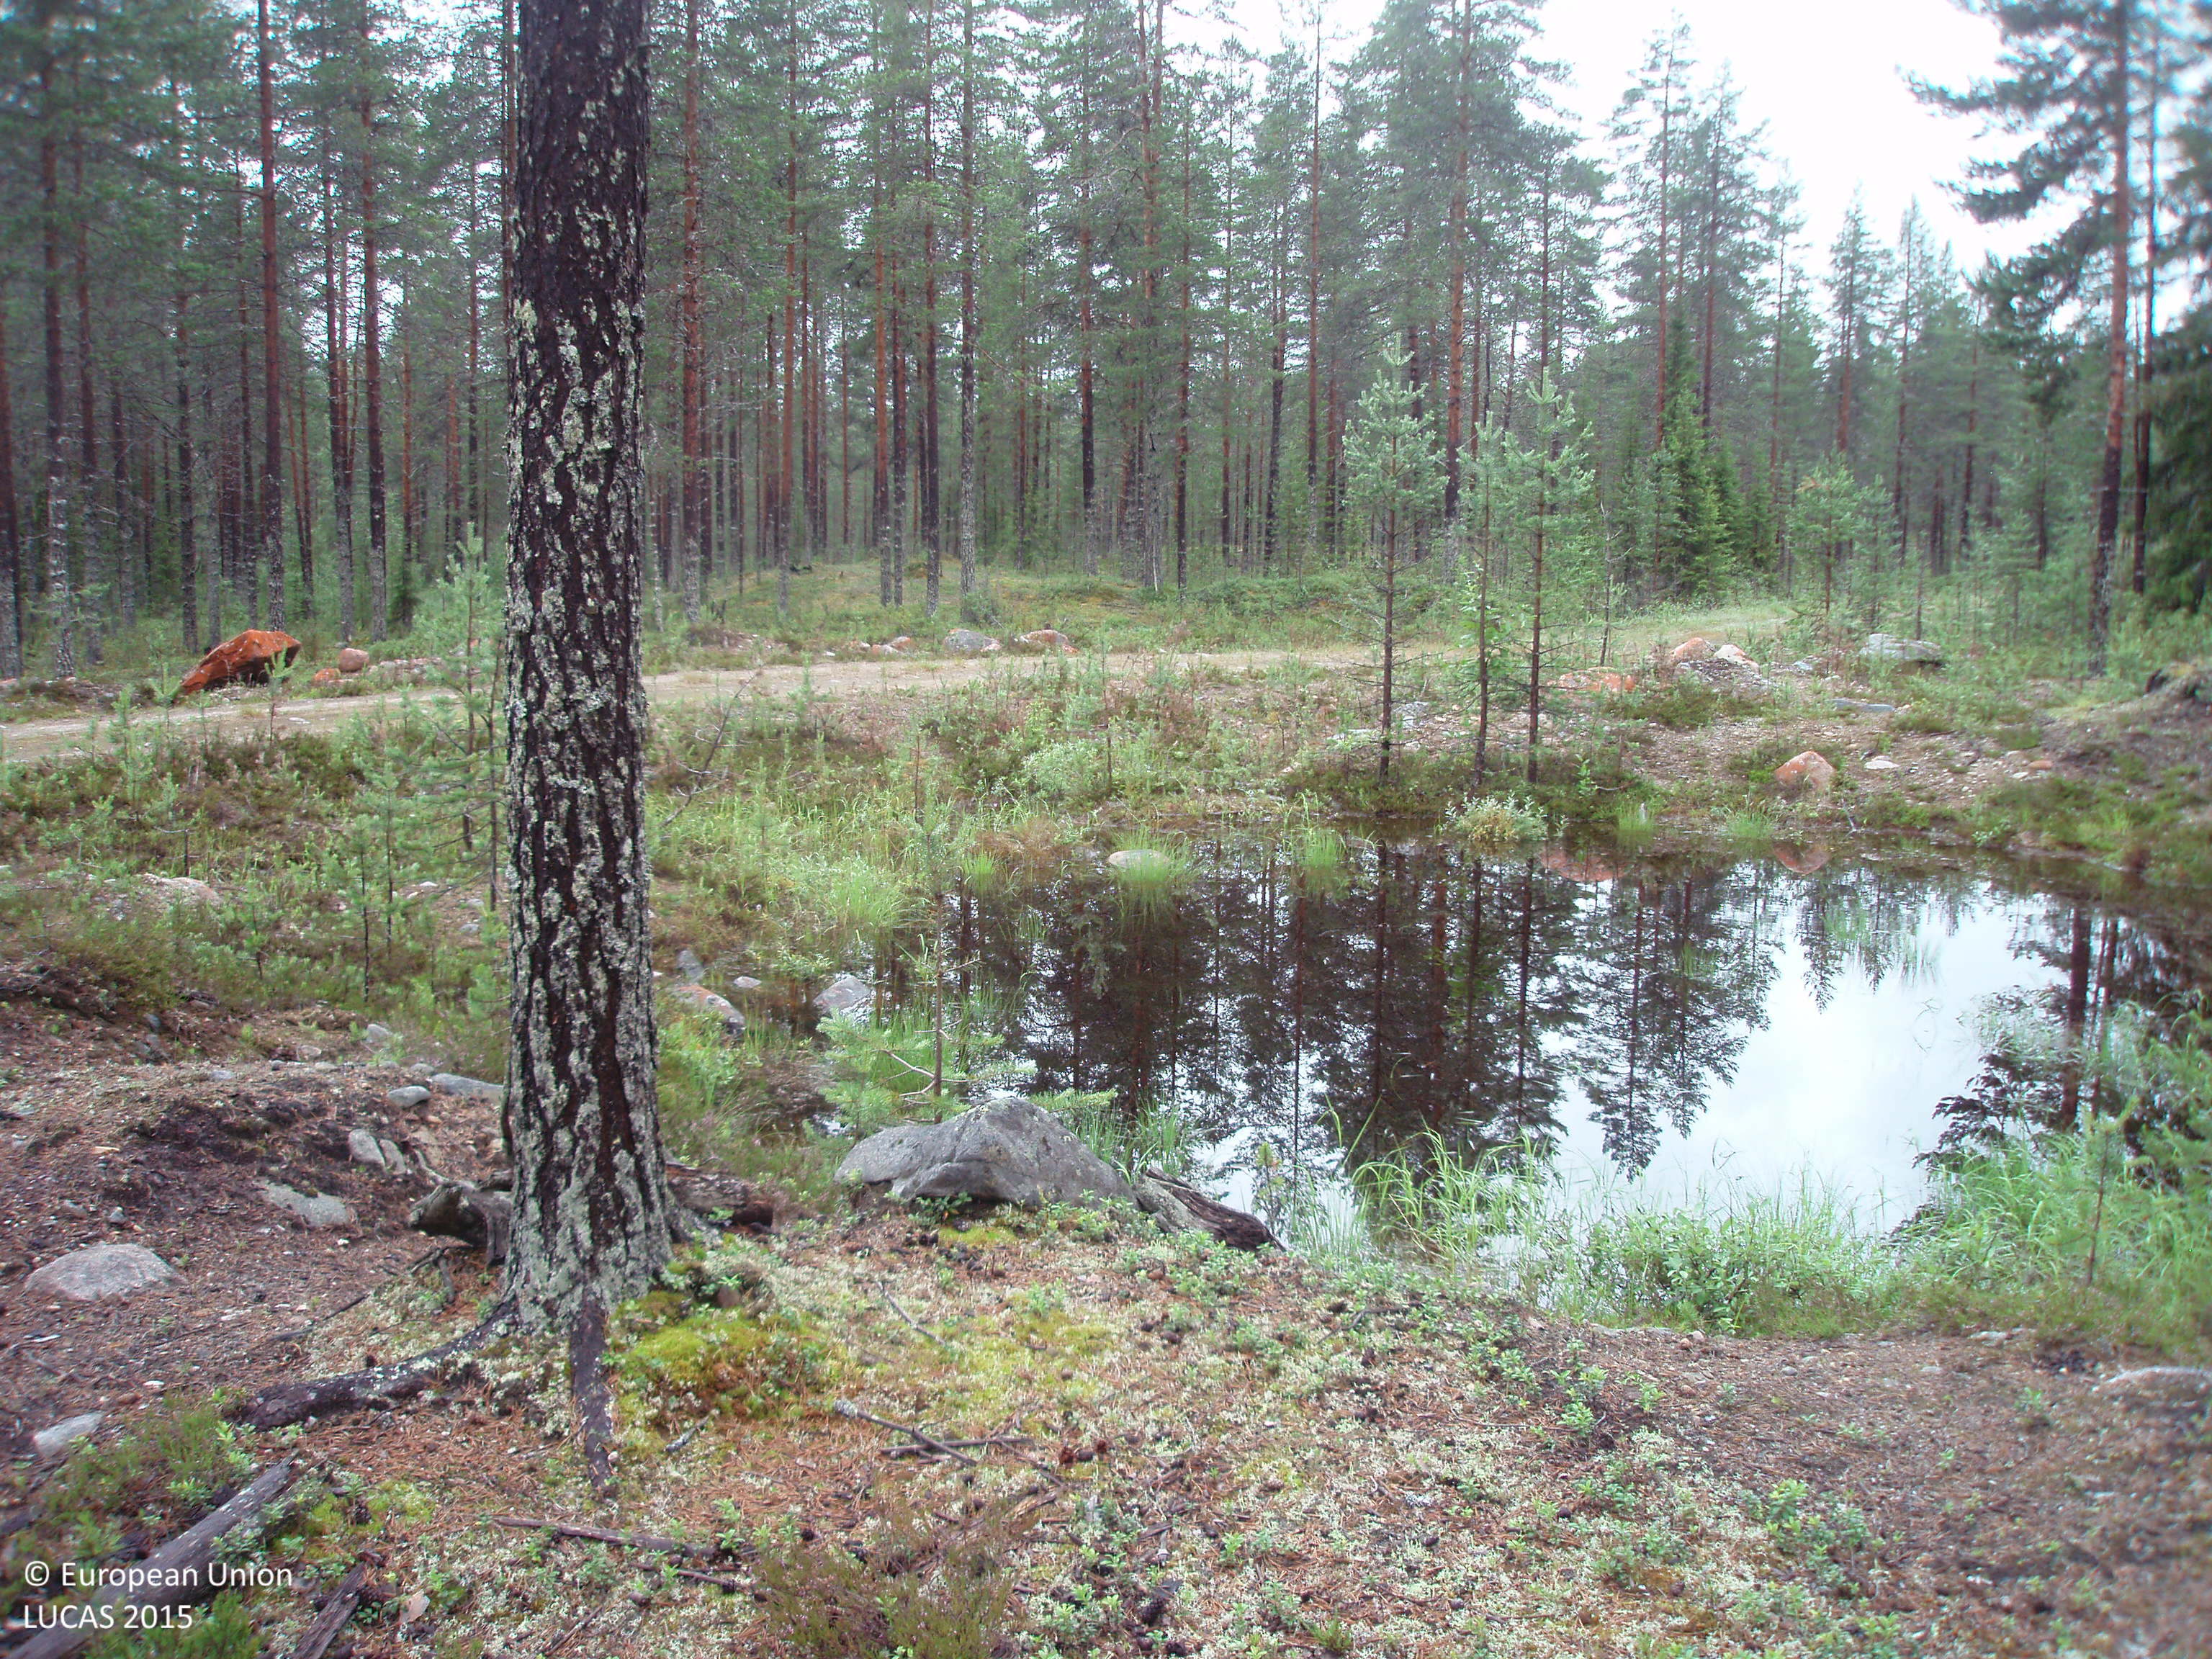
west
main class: Woodland
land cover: Pine dominated coniferous woodland
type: boreal forest
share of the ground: 50 - 75 %
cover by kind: coniferous forest trees 60 %, shrubs 30 %, lichens and mosses 10 %
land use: Forestry
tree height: > 5 m
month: July
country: FI
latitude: 65.9958
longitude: 27.9125
